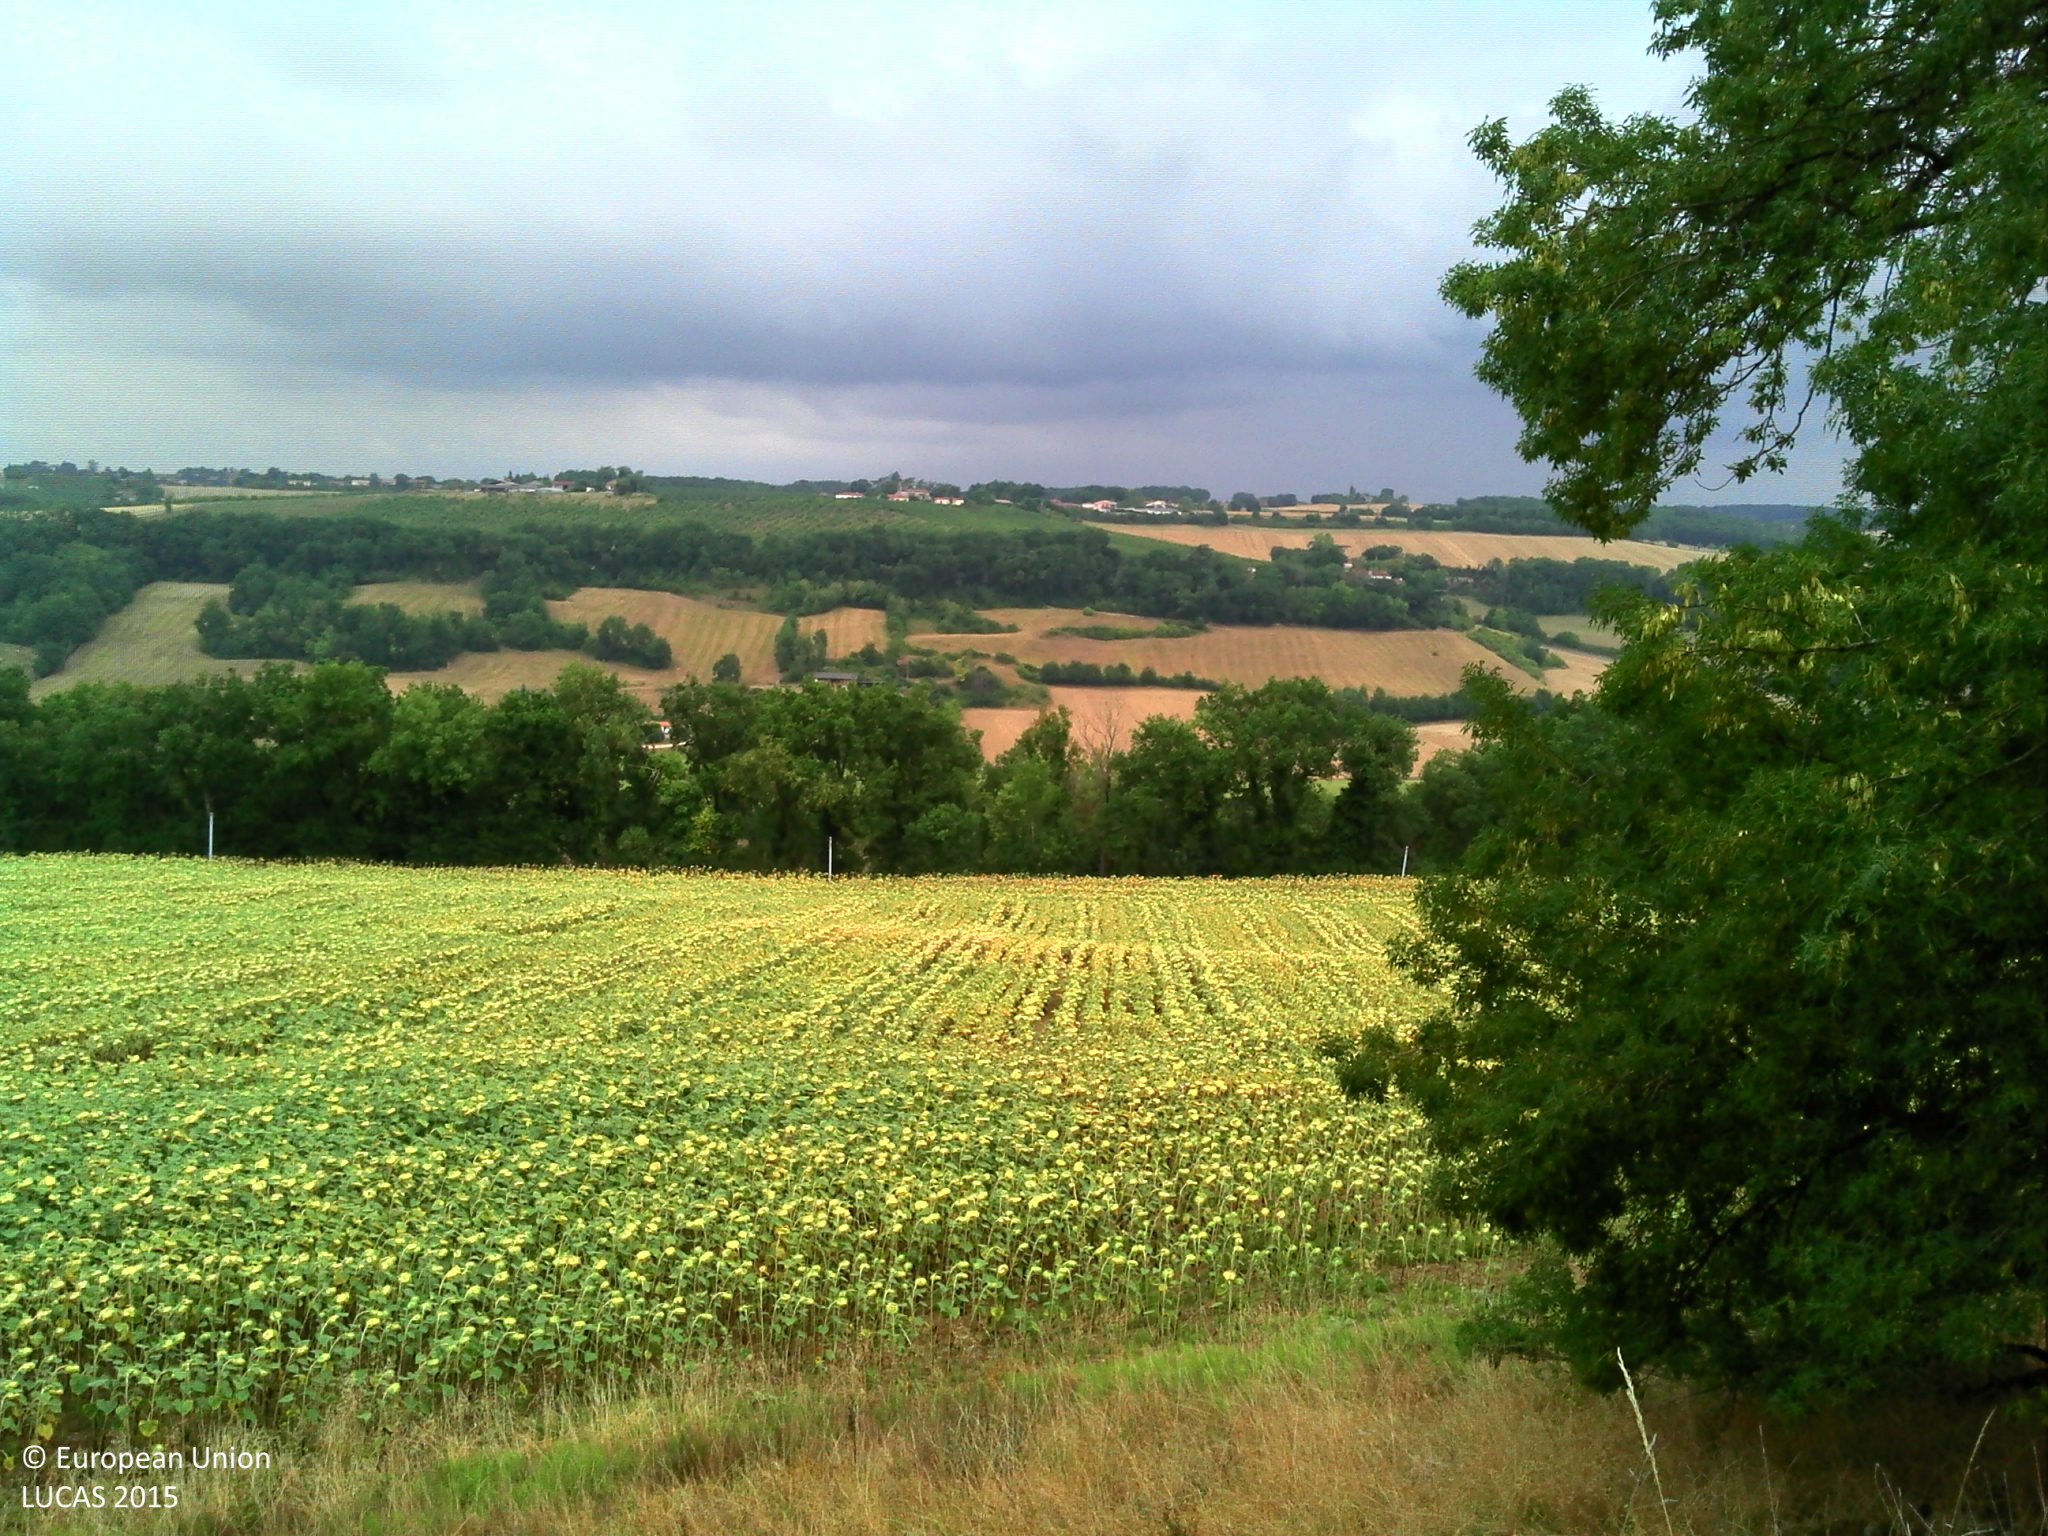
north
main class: Woodland
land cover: Broadleaved woodland
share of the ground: > 75 %
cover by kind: broadleaved forest trees 75 %, herbaceous plants 20 %, shrubs 5 %
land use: Semi-natural and natural areas not in use
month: August
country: FR
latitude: 44.2487
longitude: 0.5892
